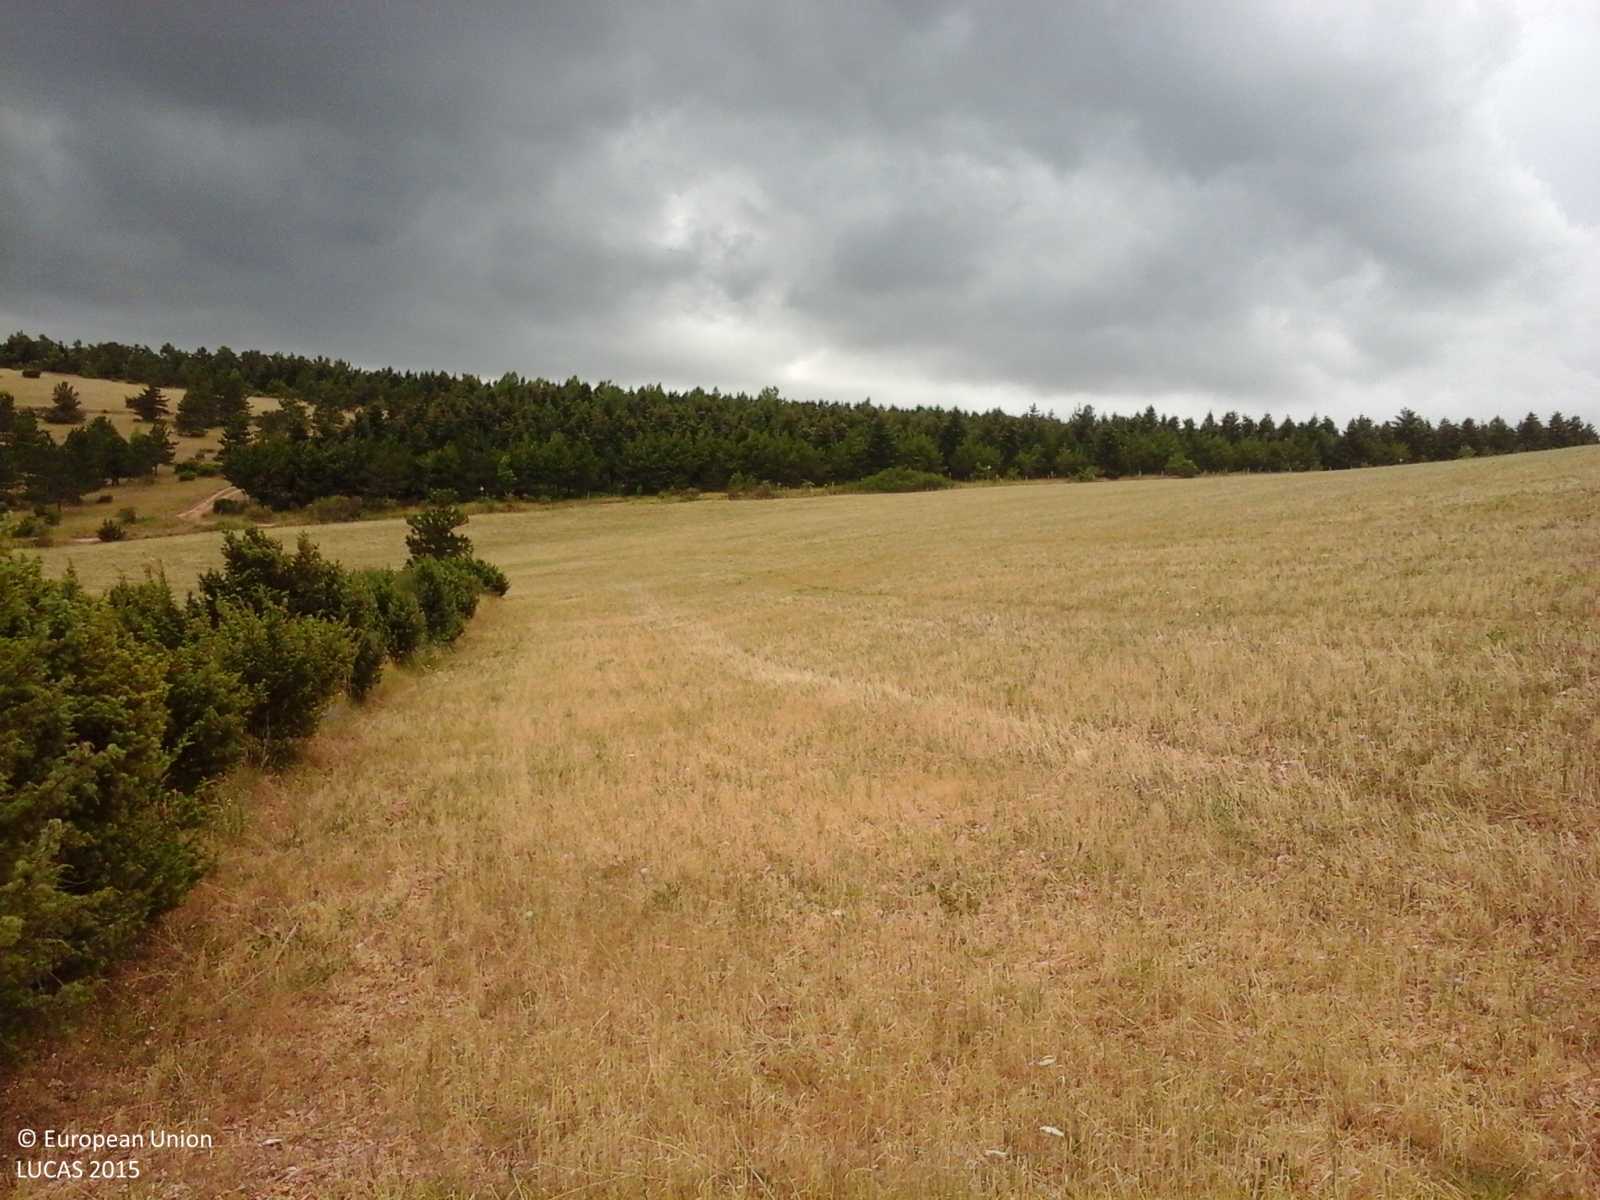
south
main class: Cropland
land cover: Triticale
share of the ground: > 75 %
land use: Agriculture (excluding fallow land and kitchen gardens)
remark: Harvested field
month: July
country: IT
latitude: 43.2380
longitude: 13.1318
